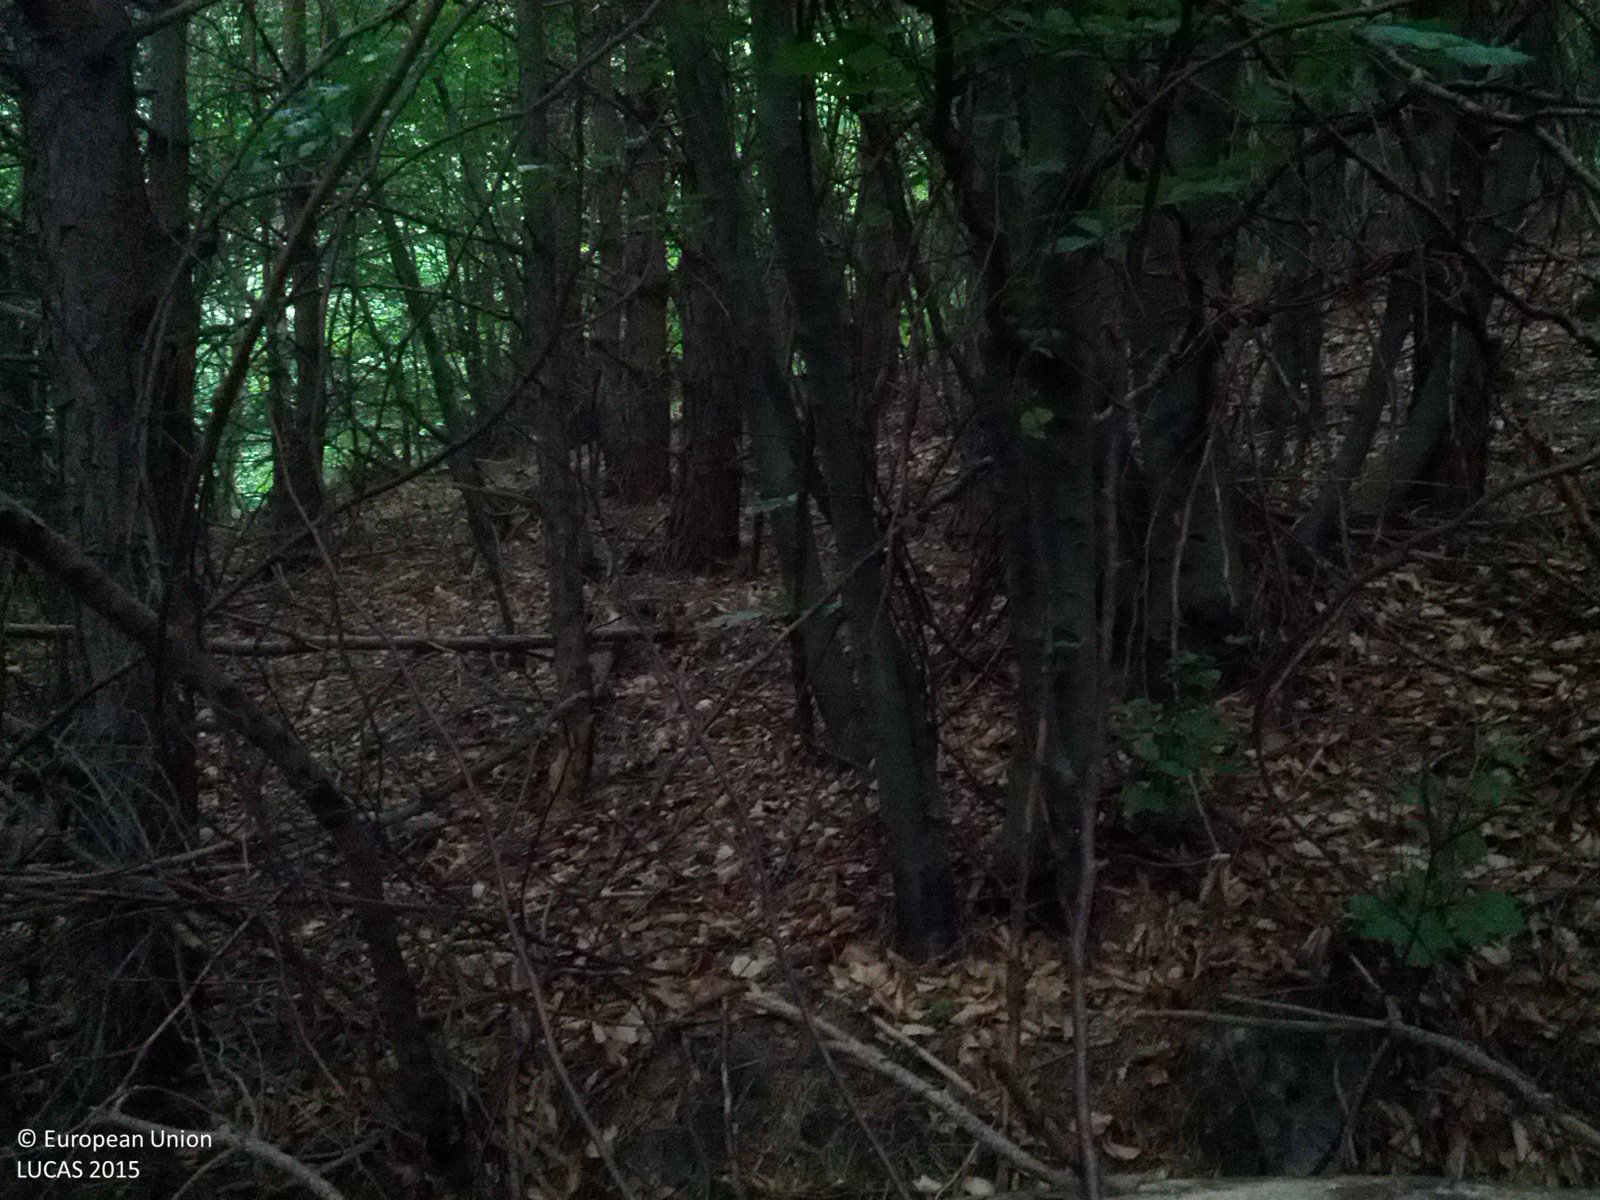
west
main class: Woodland
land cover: Broadleaved woodland
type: beech forest
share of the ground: > 75 %
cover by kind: broadleaved forest trees 100 %
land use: Forestry
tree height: > 5 m
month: June
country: AT
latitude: 48.2170
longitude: 16.1010
